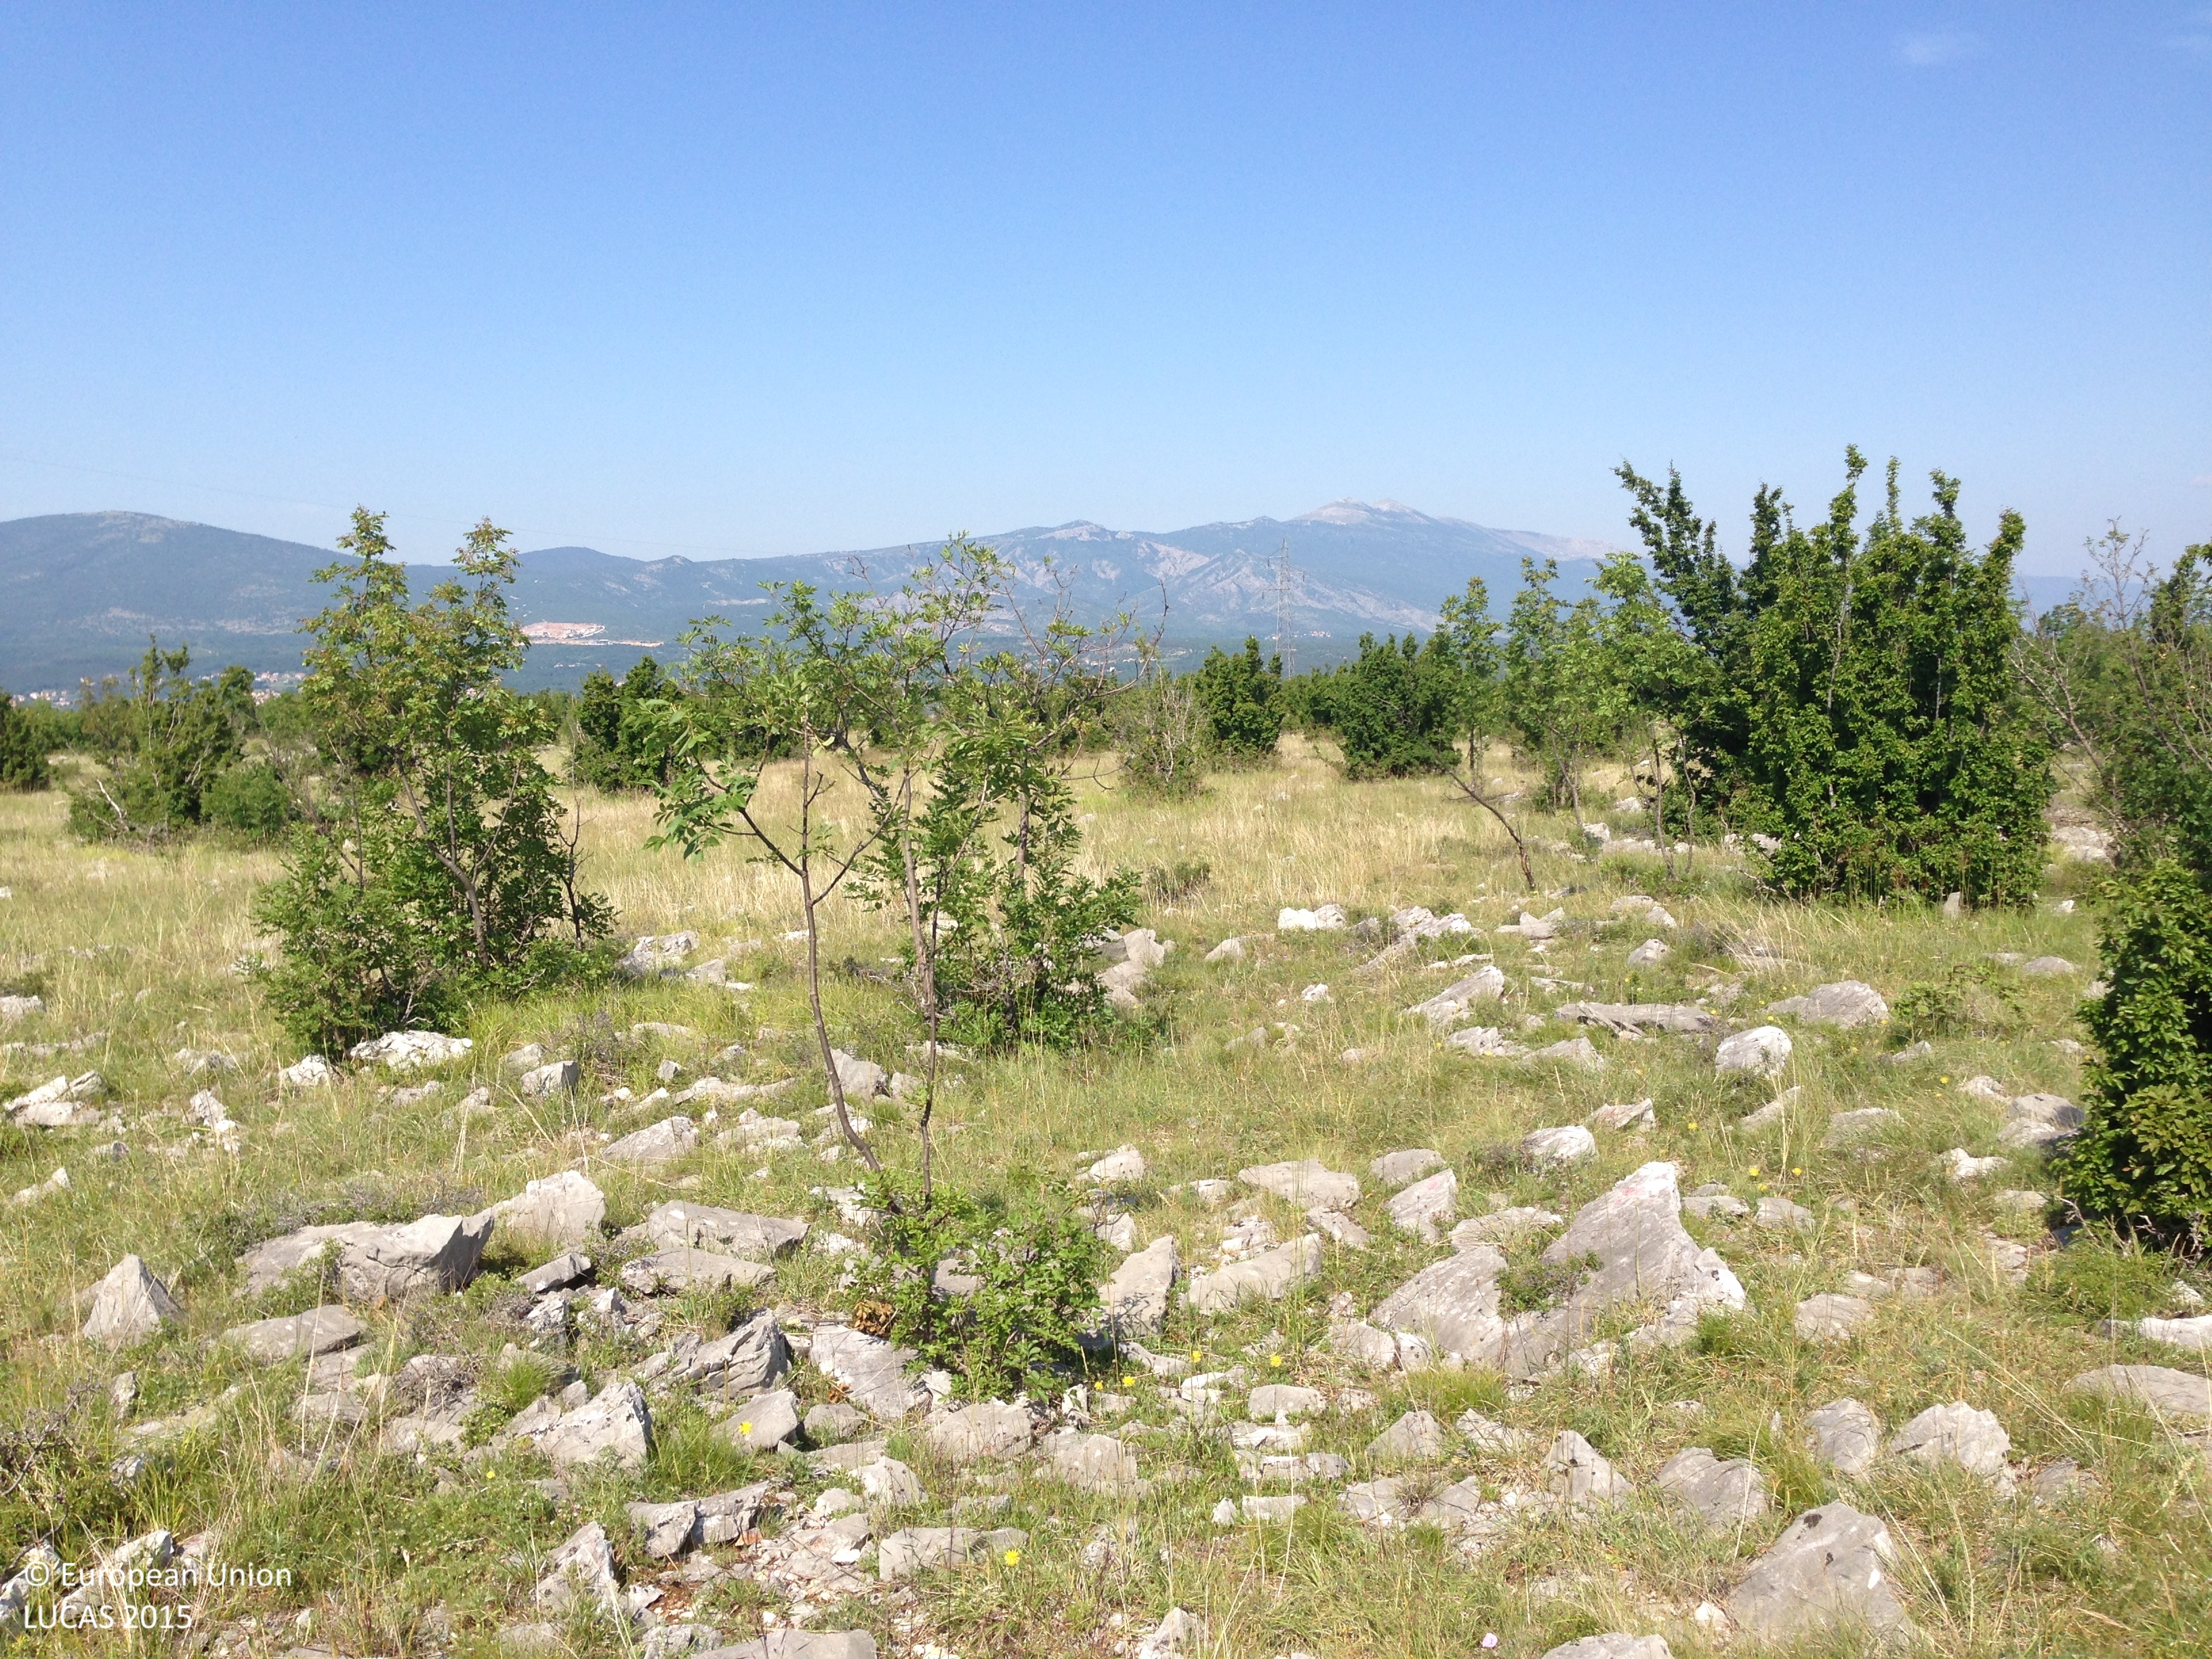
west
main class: Shrubland
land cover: Shrubland with sparse tree cover
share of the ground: 25 - 50 %
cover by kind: herbaceous plants 40 %, shrubs 25 %, unconsolidated bare surface 25 %, broadleaved forest trees 5 %, consolidated bare surface 5 %
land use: Semi-natural and natural areas not in use
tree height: < 5 m
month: June
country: HR
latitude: 43.7743
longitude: 16.6639
